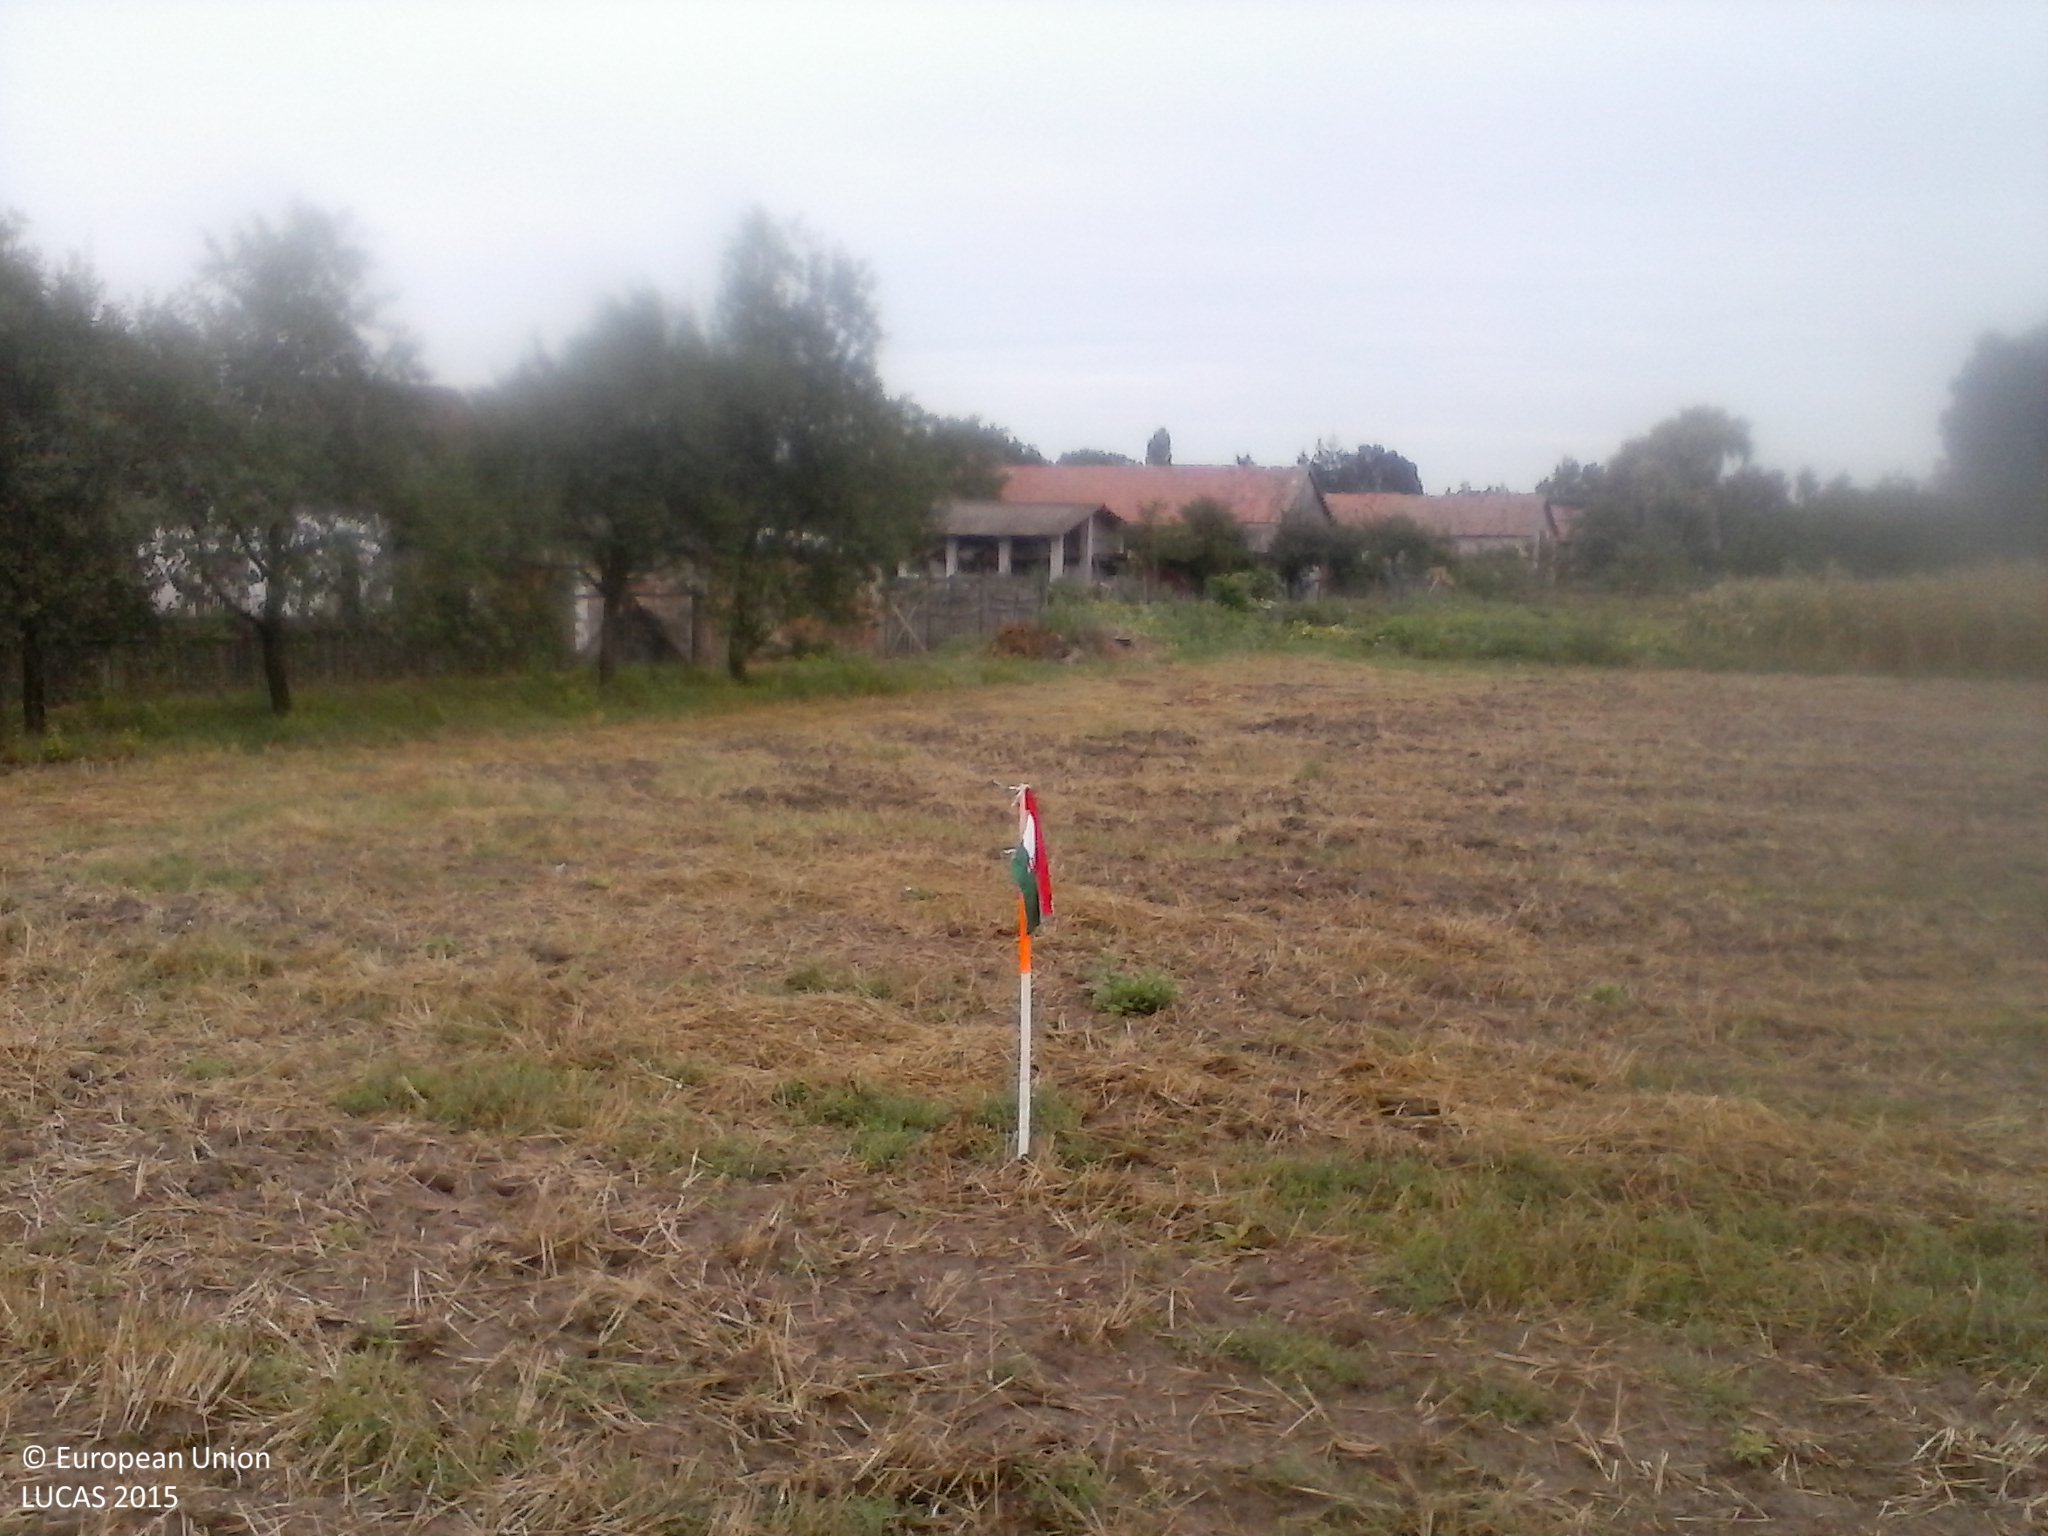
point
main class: Cropland
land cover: Common wheat
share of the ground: < 10 %
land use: Agriculture (excluding fallow land and kitchen gardens)
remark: Harvested field
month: July
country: HU
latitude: 45.9445
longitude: 17.7309
